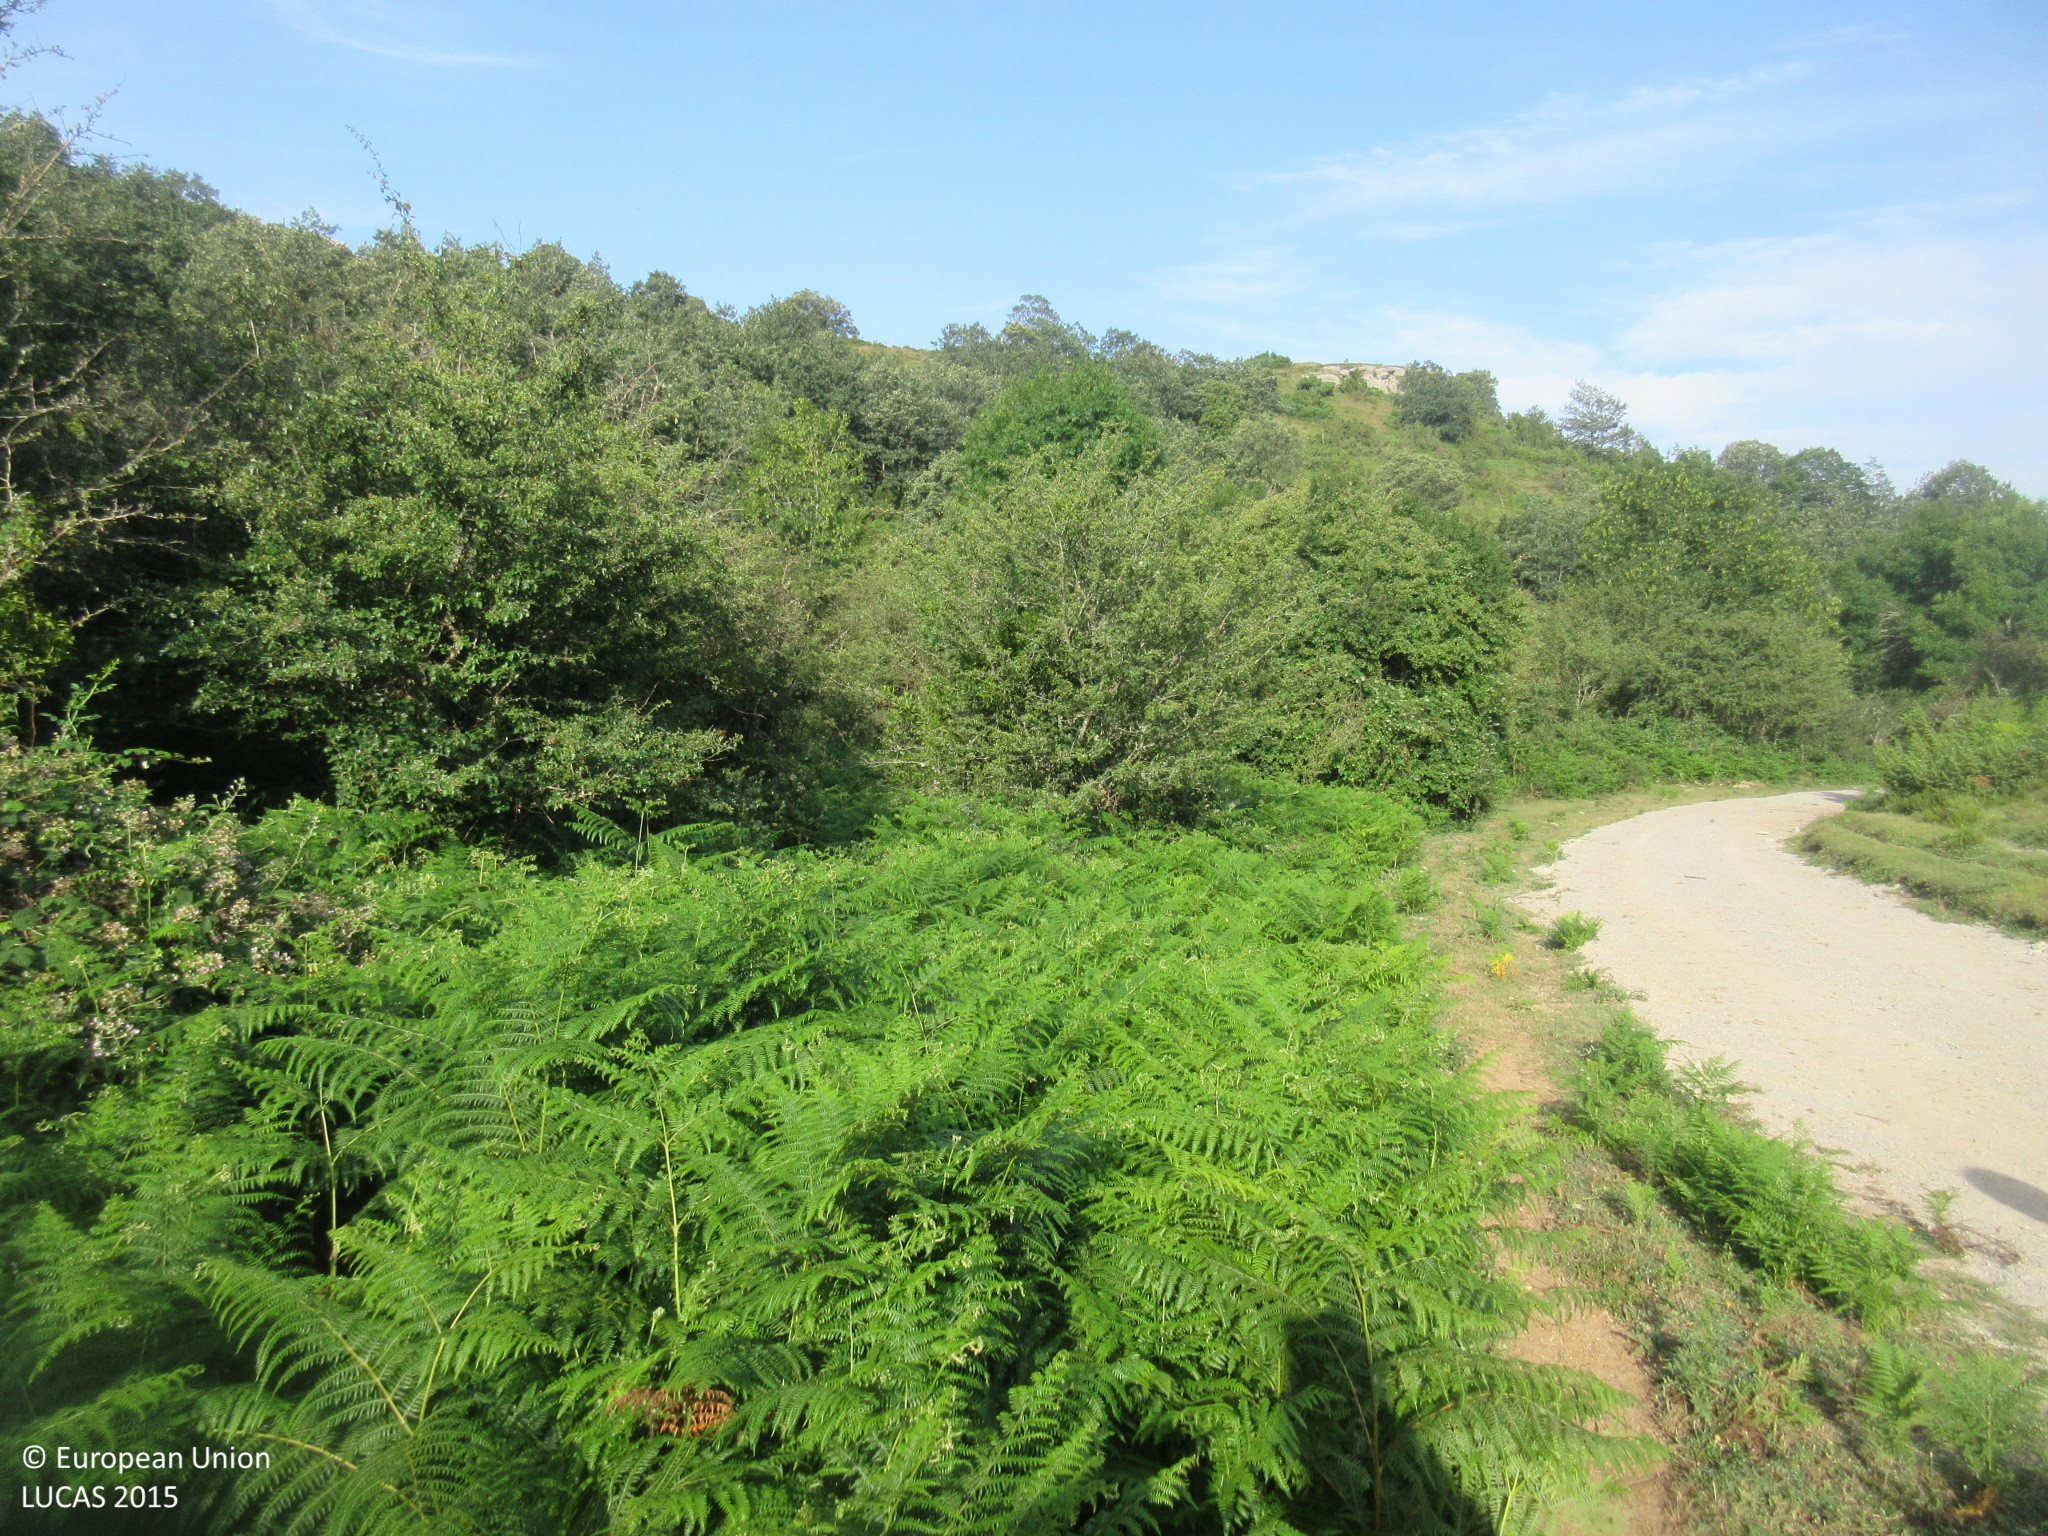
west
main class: Woodland
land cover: Broadleaved woodland
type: thermophilous deciduous forest
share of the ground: > 75 %
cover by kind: broadleaved forest trees 80 %, herbaceous plants 20 %
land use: Agriculture (excluding fallow land and kitchen gardens)
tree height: > 5 m
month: July
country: ES
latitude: 43.0587
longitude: -3.3854
